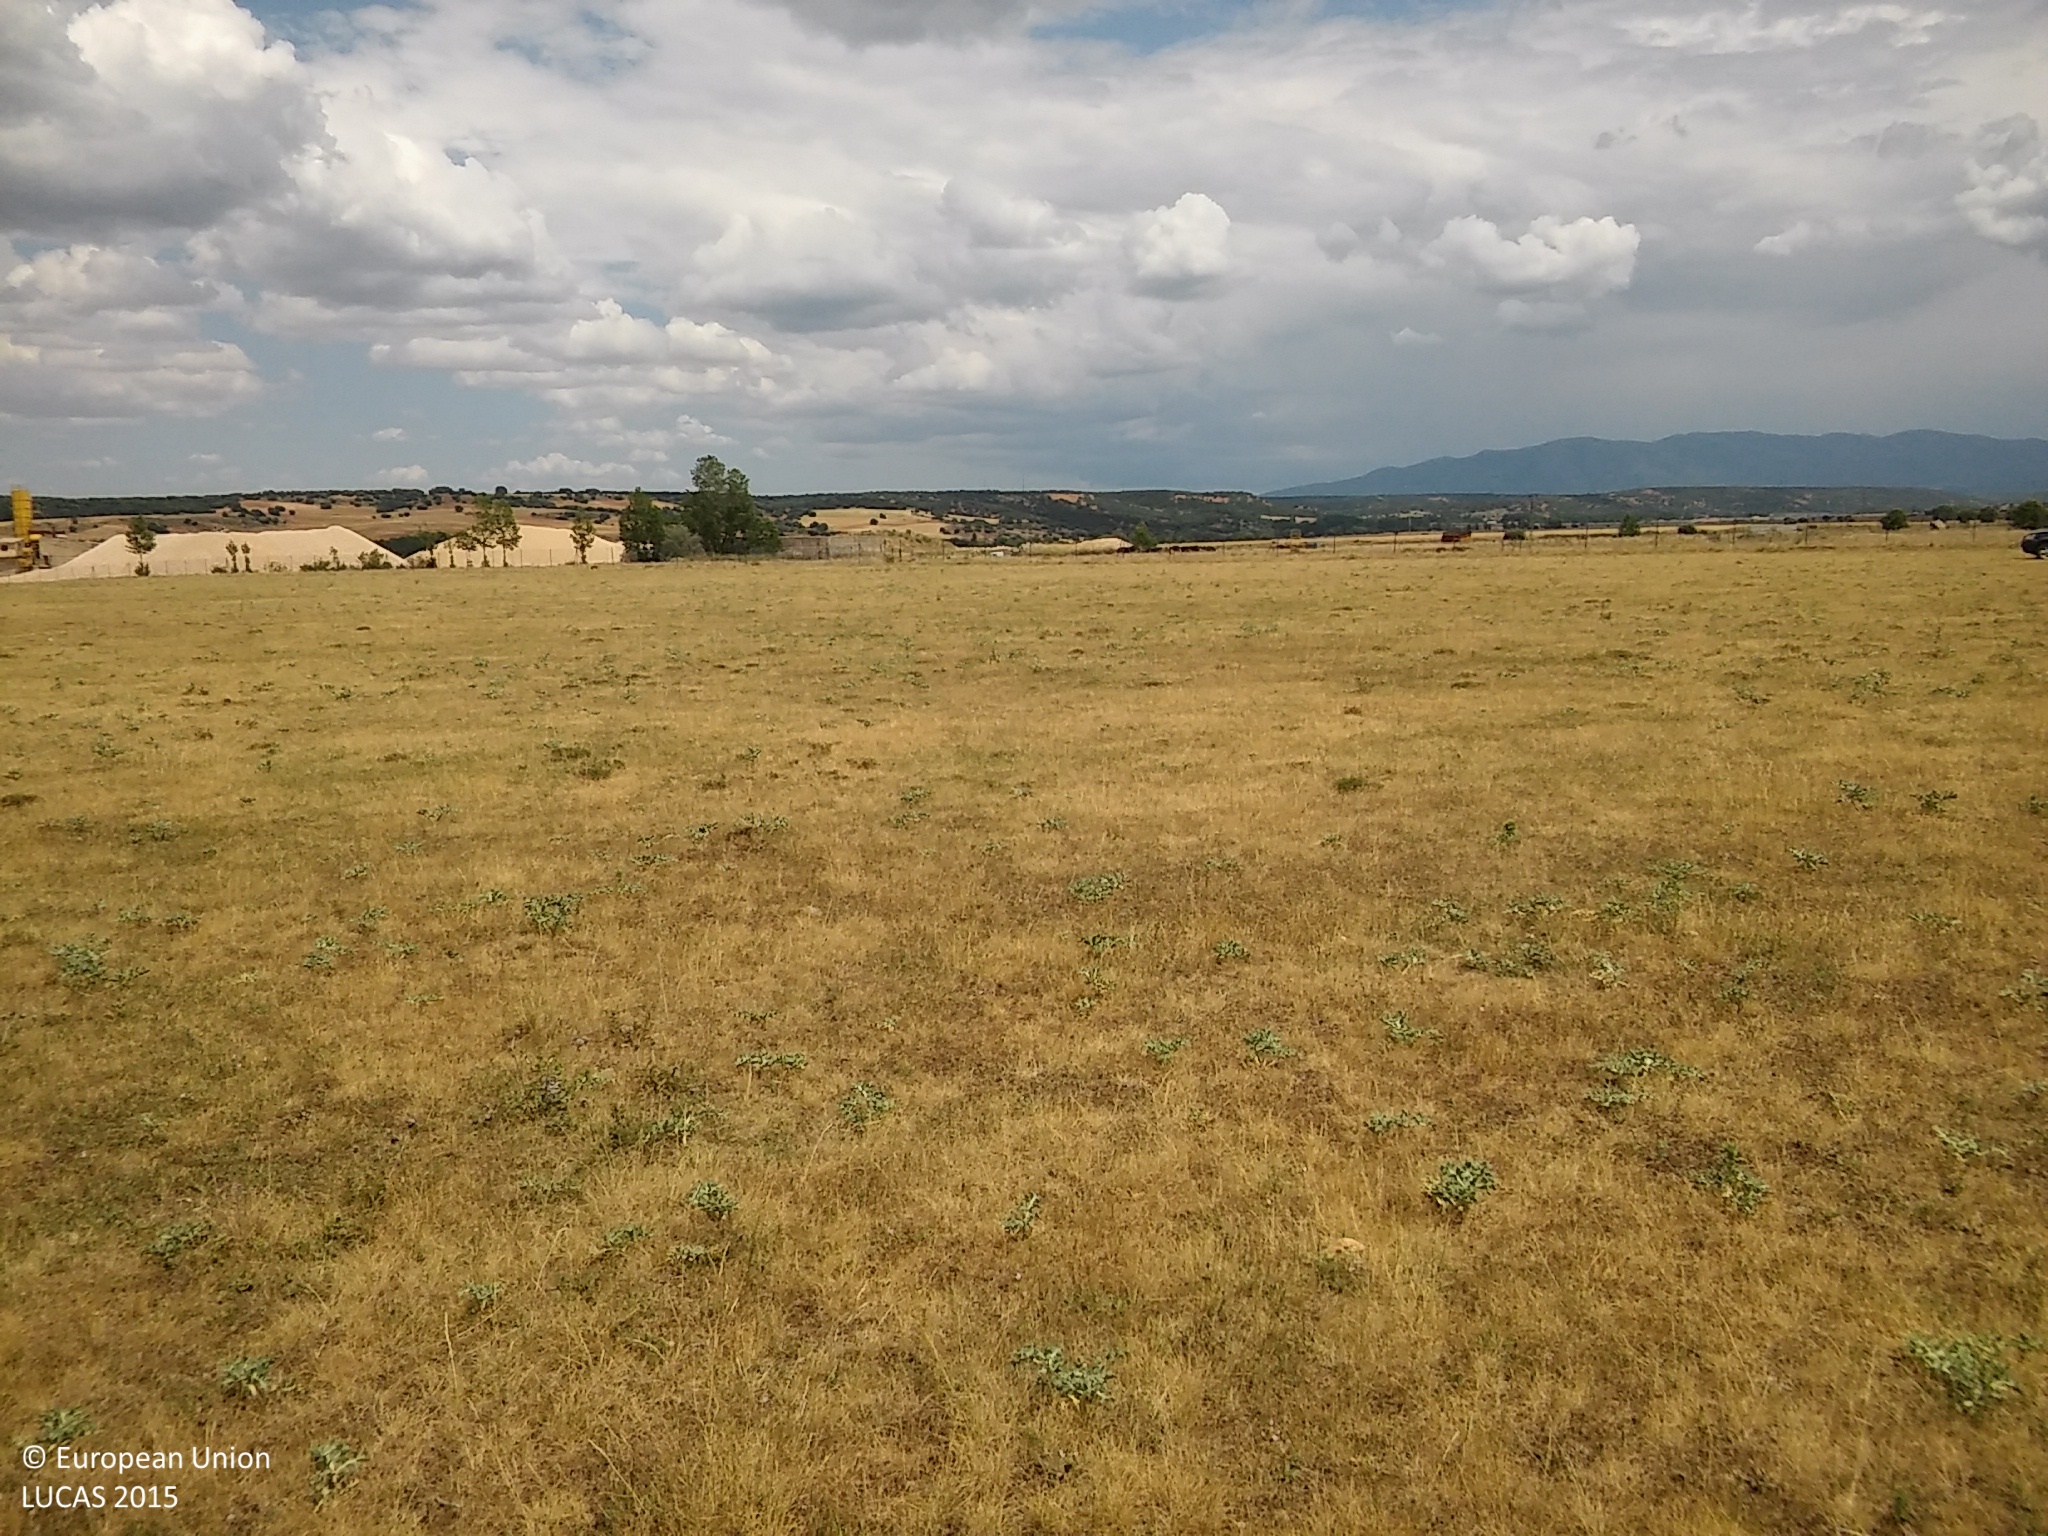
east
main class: Grassland
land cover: Grassland without tree/shrub cover
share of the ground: > 75 %
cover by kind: herbaceous plants 100 %
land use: Agriculture (excluding fallow land and kitchen gardens)
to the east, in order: Grassland without tree/shrub cover; Tracks; Grassland without tree/shrub cover; Ditches and canals; Grass margins; Fences; Grassland without tree/shrub cover
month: June
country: ES
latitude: 41.2863
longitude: -3.6476
